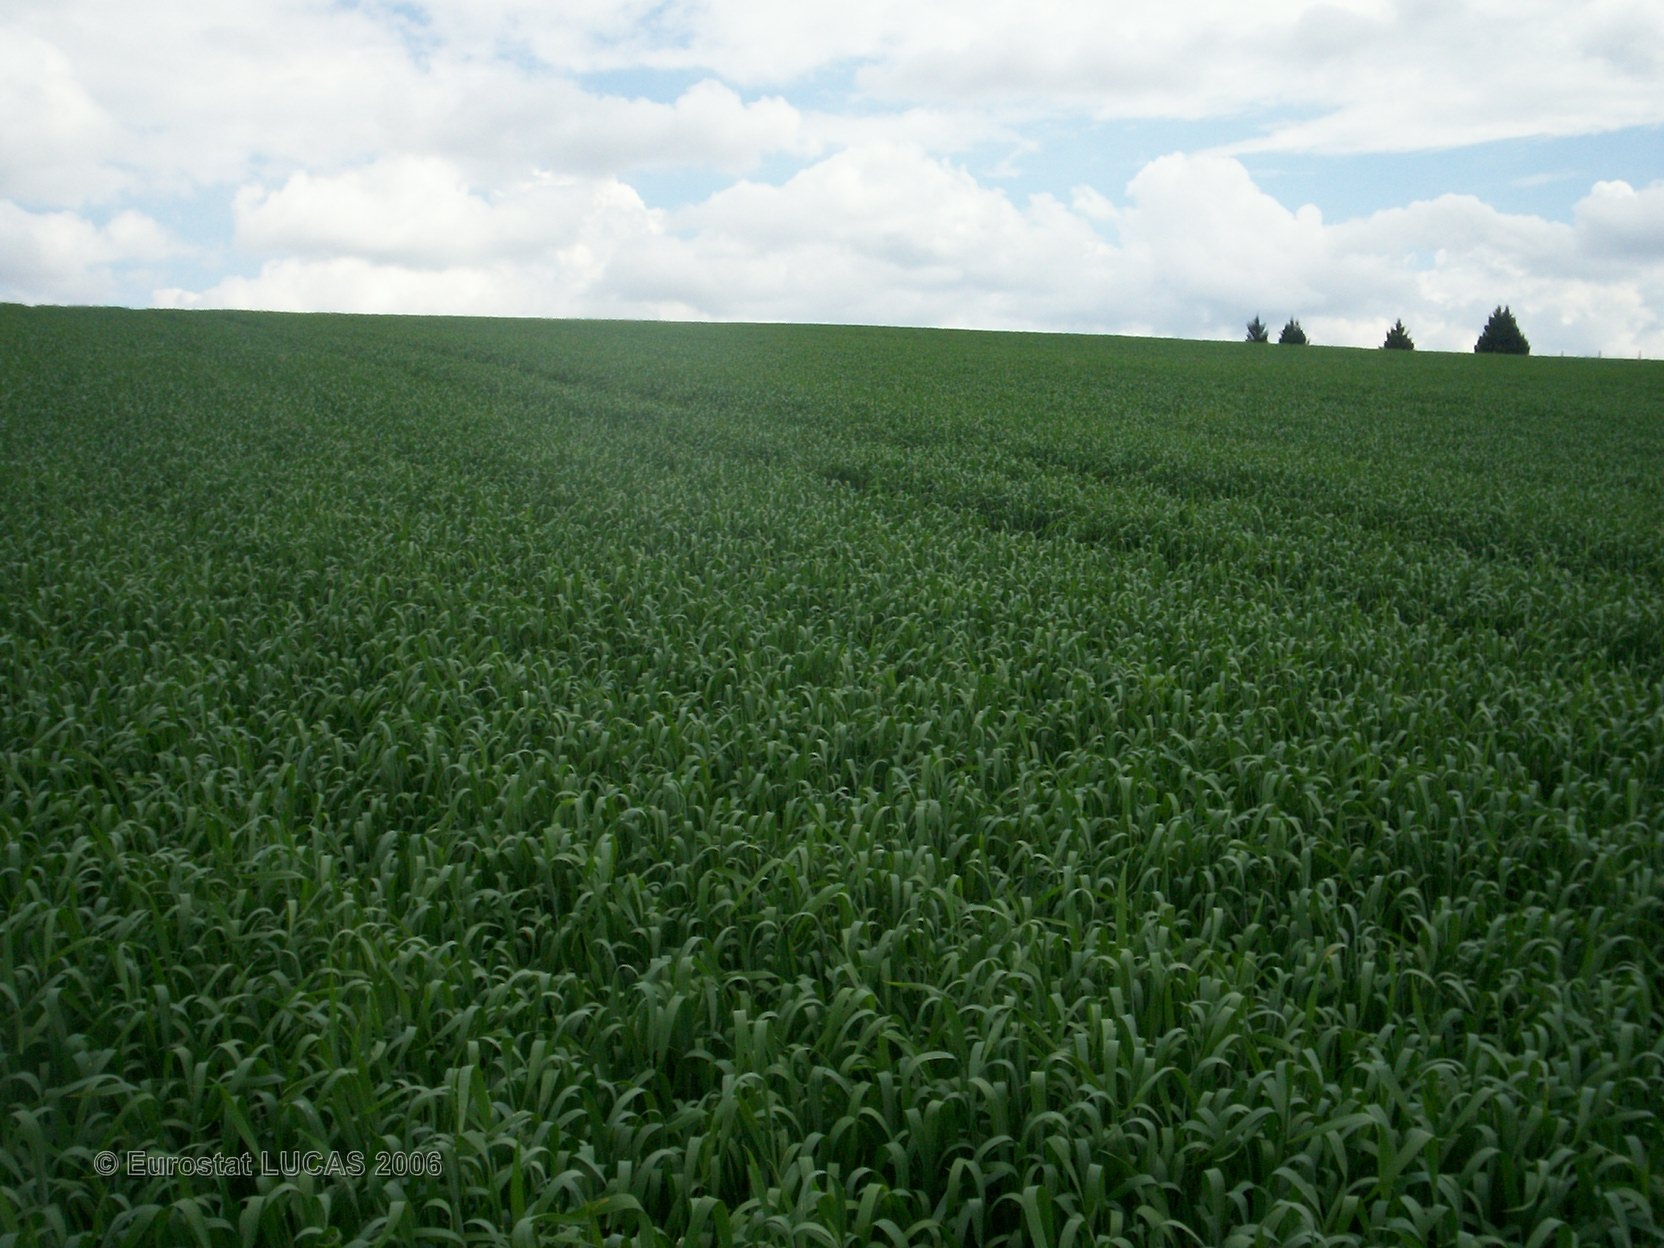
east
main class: Cropland
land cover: Common wheat
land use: Agriculture (excluding fallow land and kitchen gardens)
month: May
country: FR
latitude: 45.6279
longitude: 3.1895
